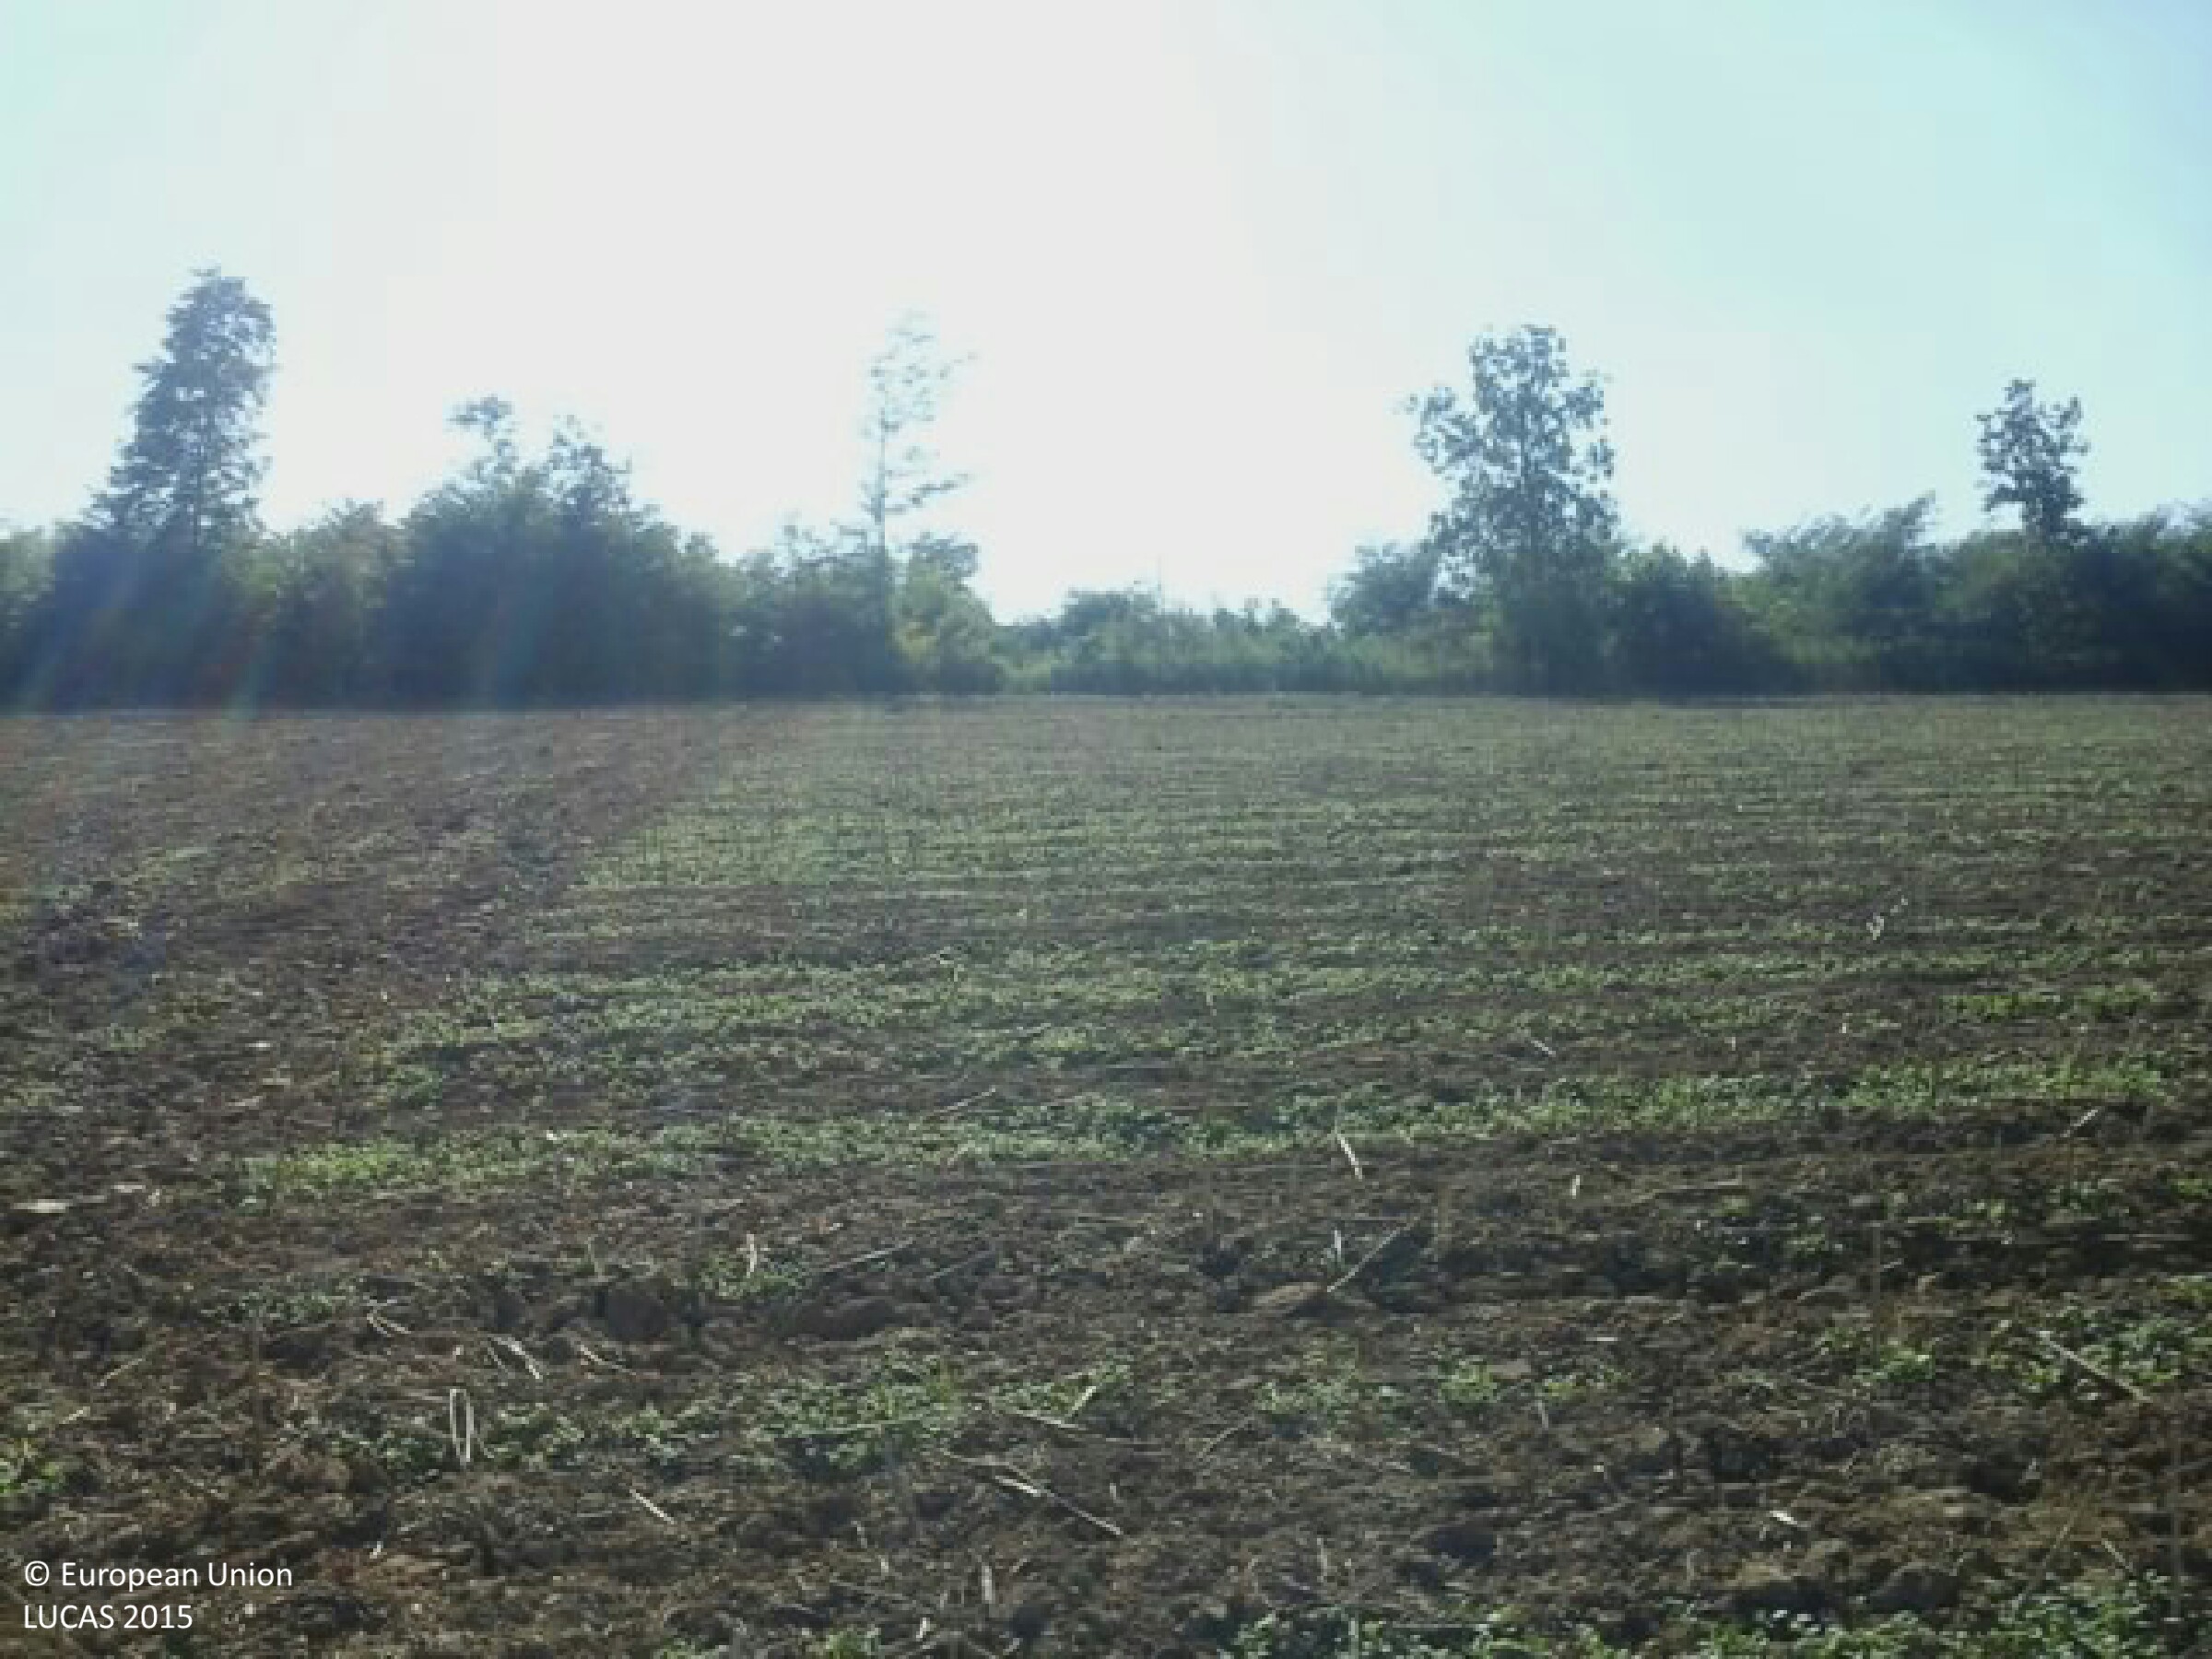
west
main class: Cropland
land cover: Common wheat
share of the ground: < 10 %
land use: Agriculture (excluding fallow land and kitchen gardens)
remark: Harvested field
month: July
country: HU
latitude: 46.4853
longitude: 17.7570
